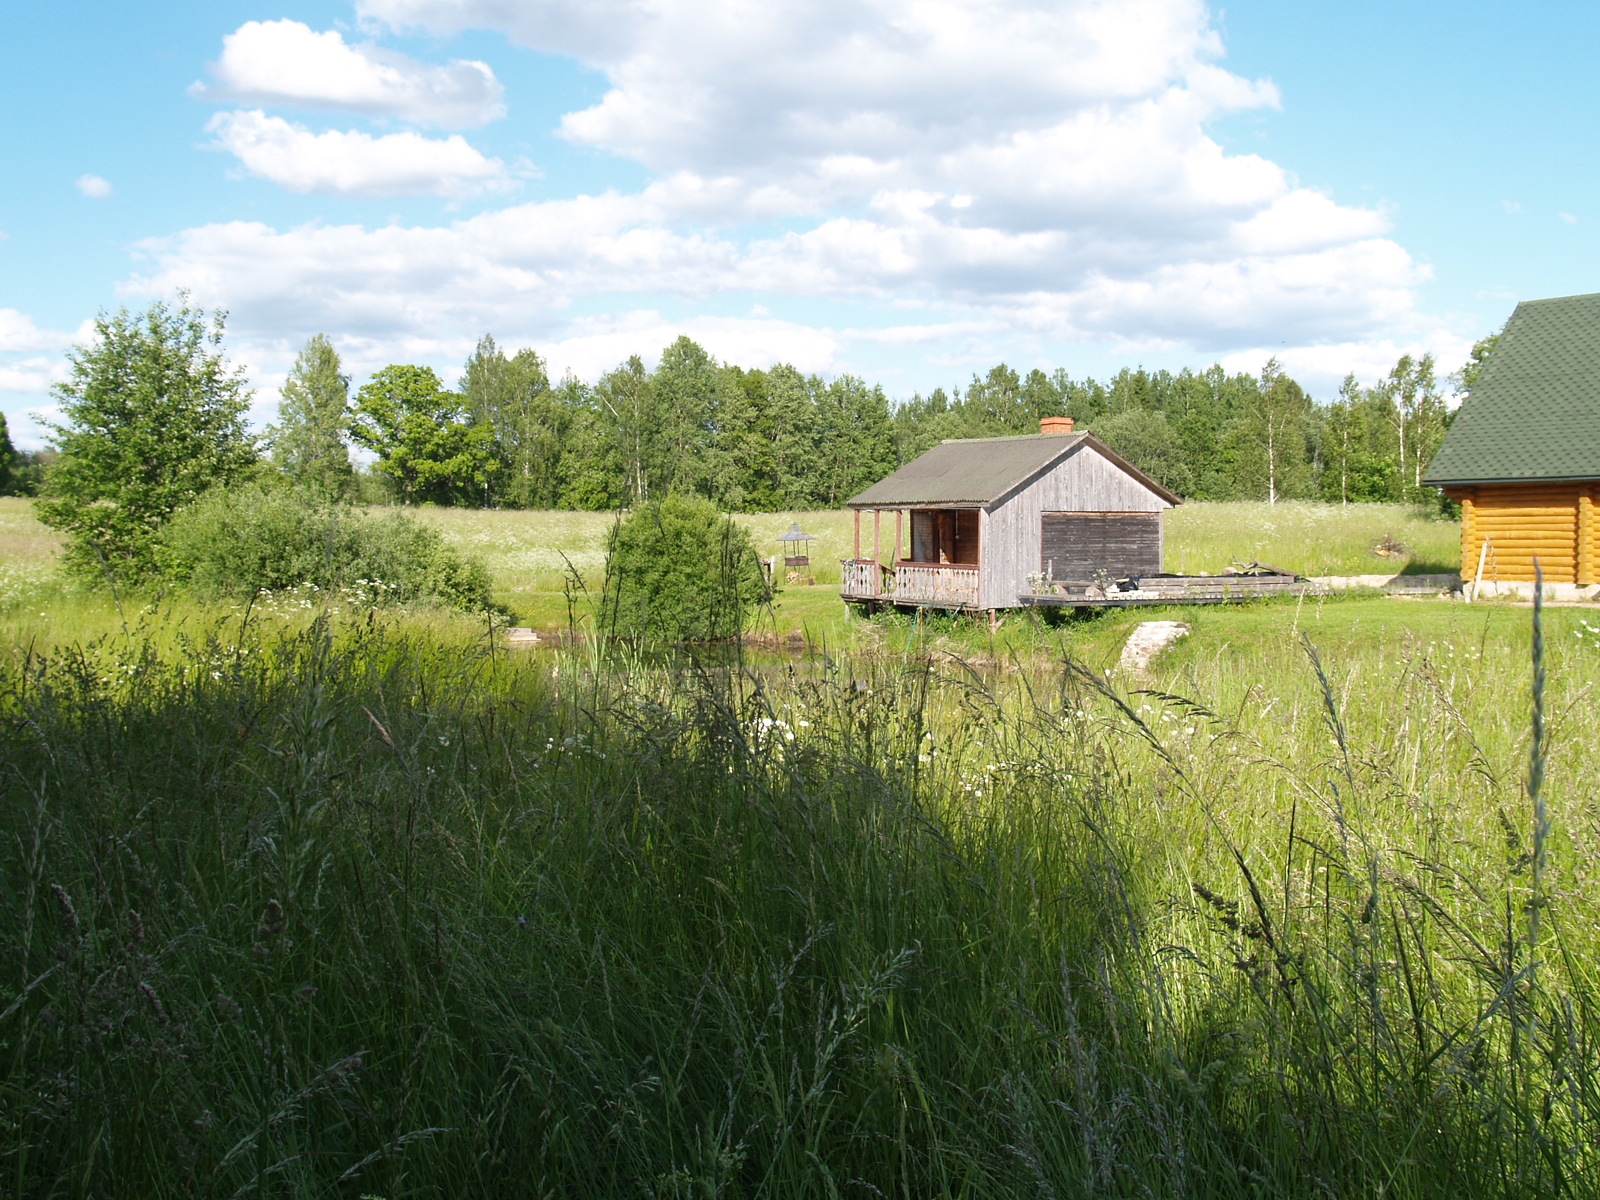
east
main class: Grassland
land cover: Grassland without tree/shrub cover
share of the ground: > 75 %
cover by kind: herbaceous plants 100 %
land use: Agriculture (excluding fallow land and kitchen gardens)
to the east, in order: Grassland without tree/shrub cover; Inland fresh water bodies; Artificial constructions in urban areas; Grassland without tree/shrub cover; Broadleaved woodland
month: June
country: LV
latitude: 56.6139
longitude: 25.6520
